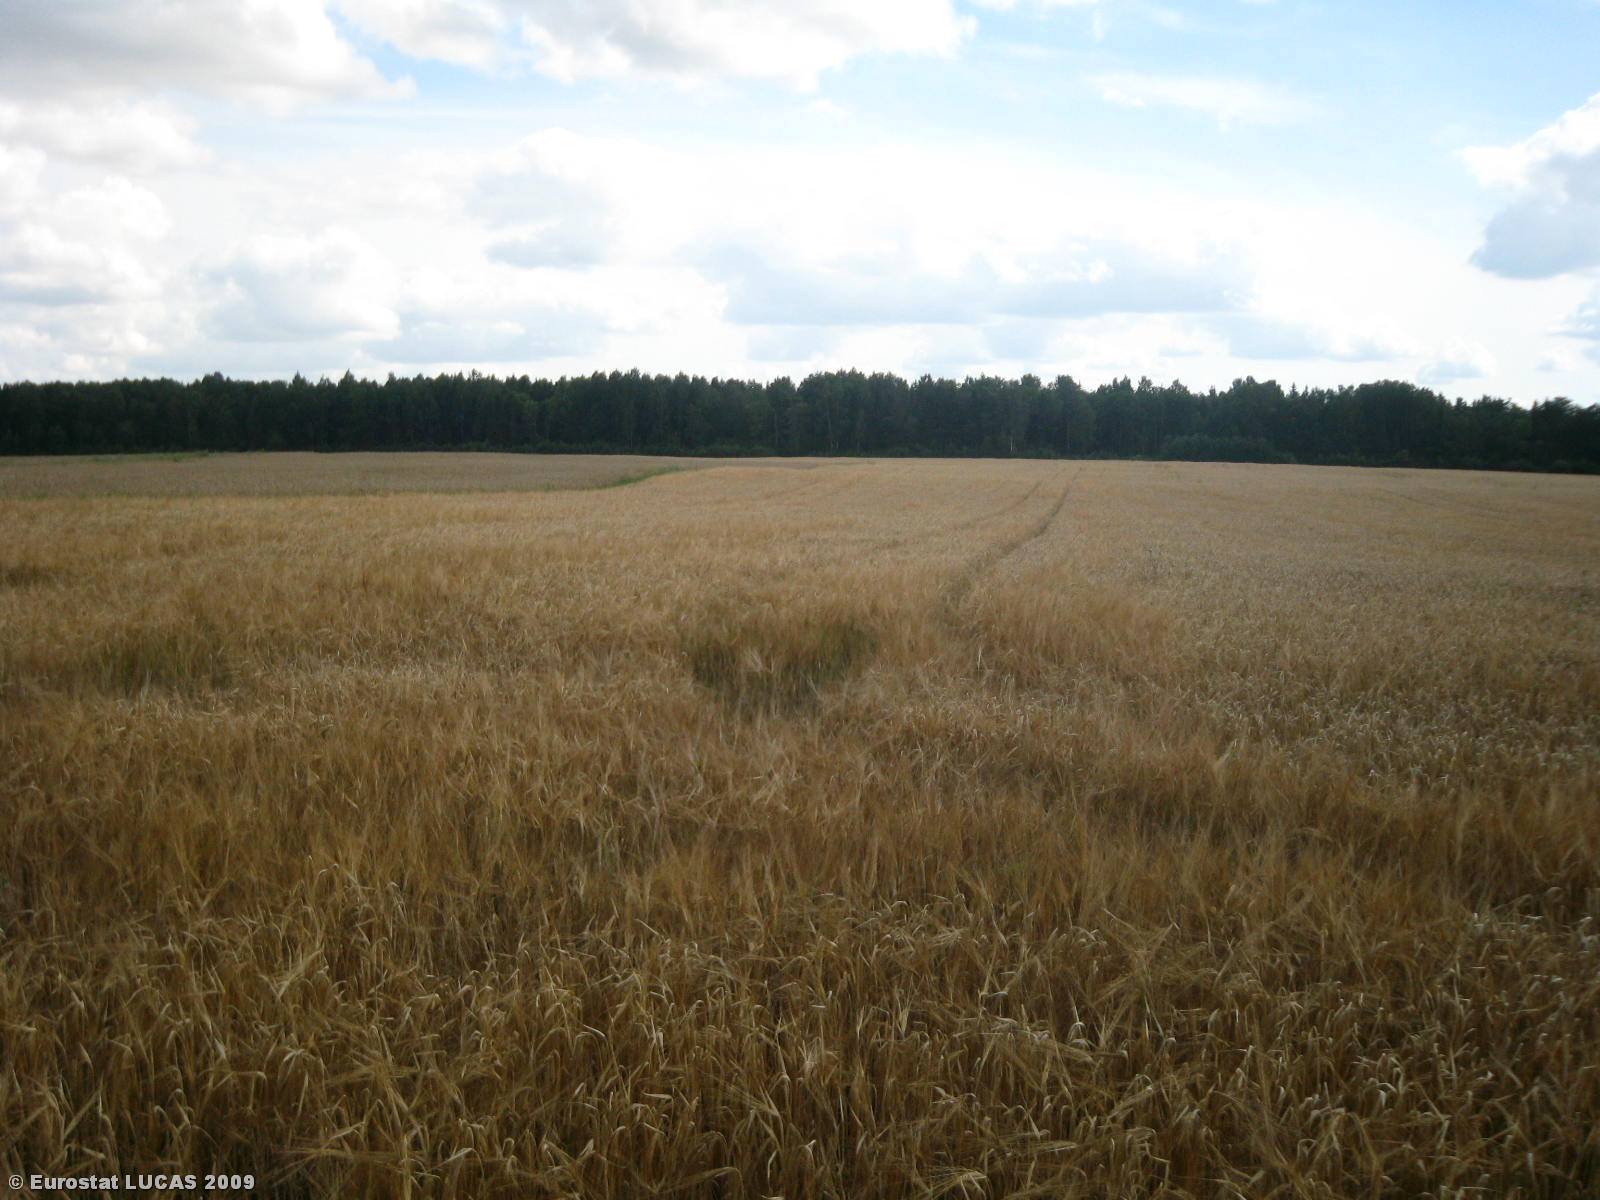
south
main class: Cropland
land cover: Barley
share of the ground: > 75 %
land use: Agriculture (excluding fallow land and kitchen gardens)
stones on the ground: < 10 %
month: August
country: LT
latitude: 55.3363
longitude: 23.7209
